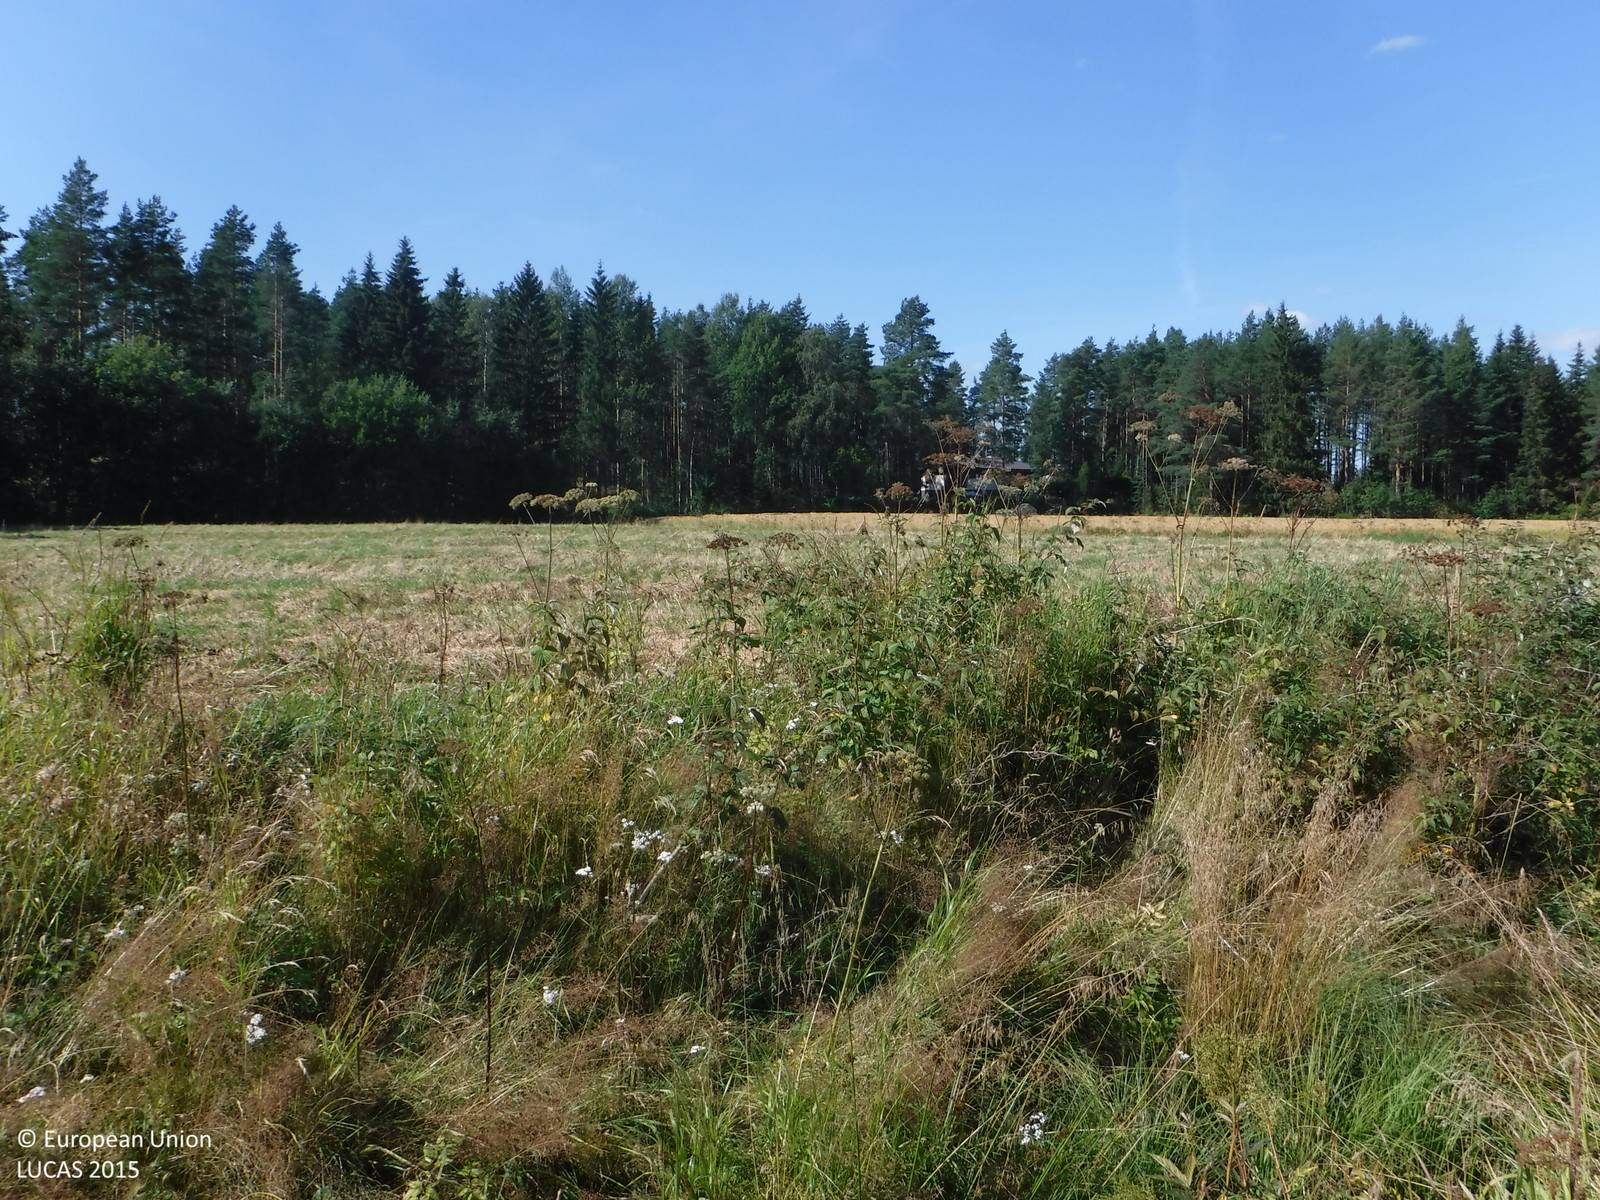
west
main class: Cropland
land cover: Common wheat
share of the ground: > 75 %
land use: Agriculture (excluding fallow land and kitchen gardens)
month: August
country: FI
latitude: 61.1171
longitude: 22.1055
